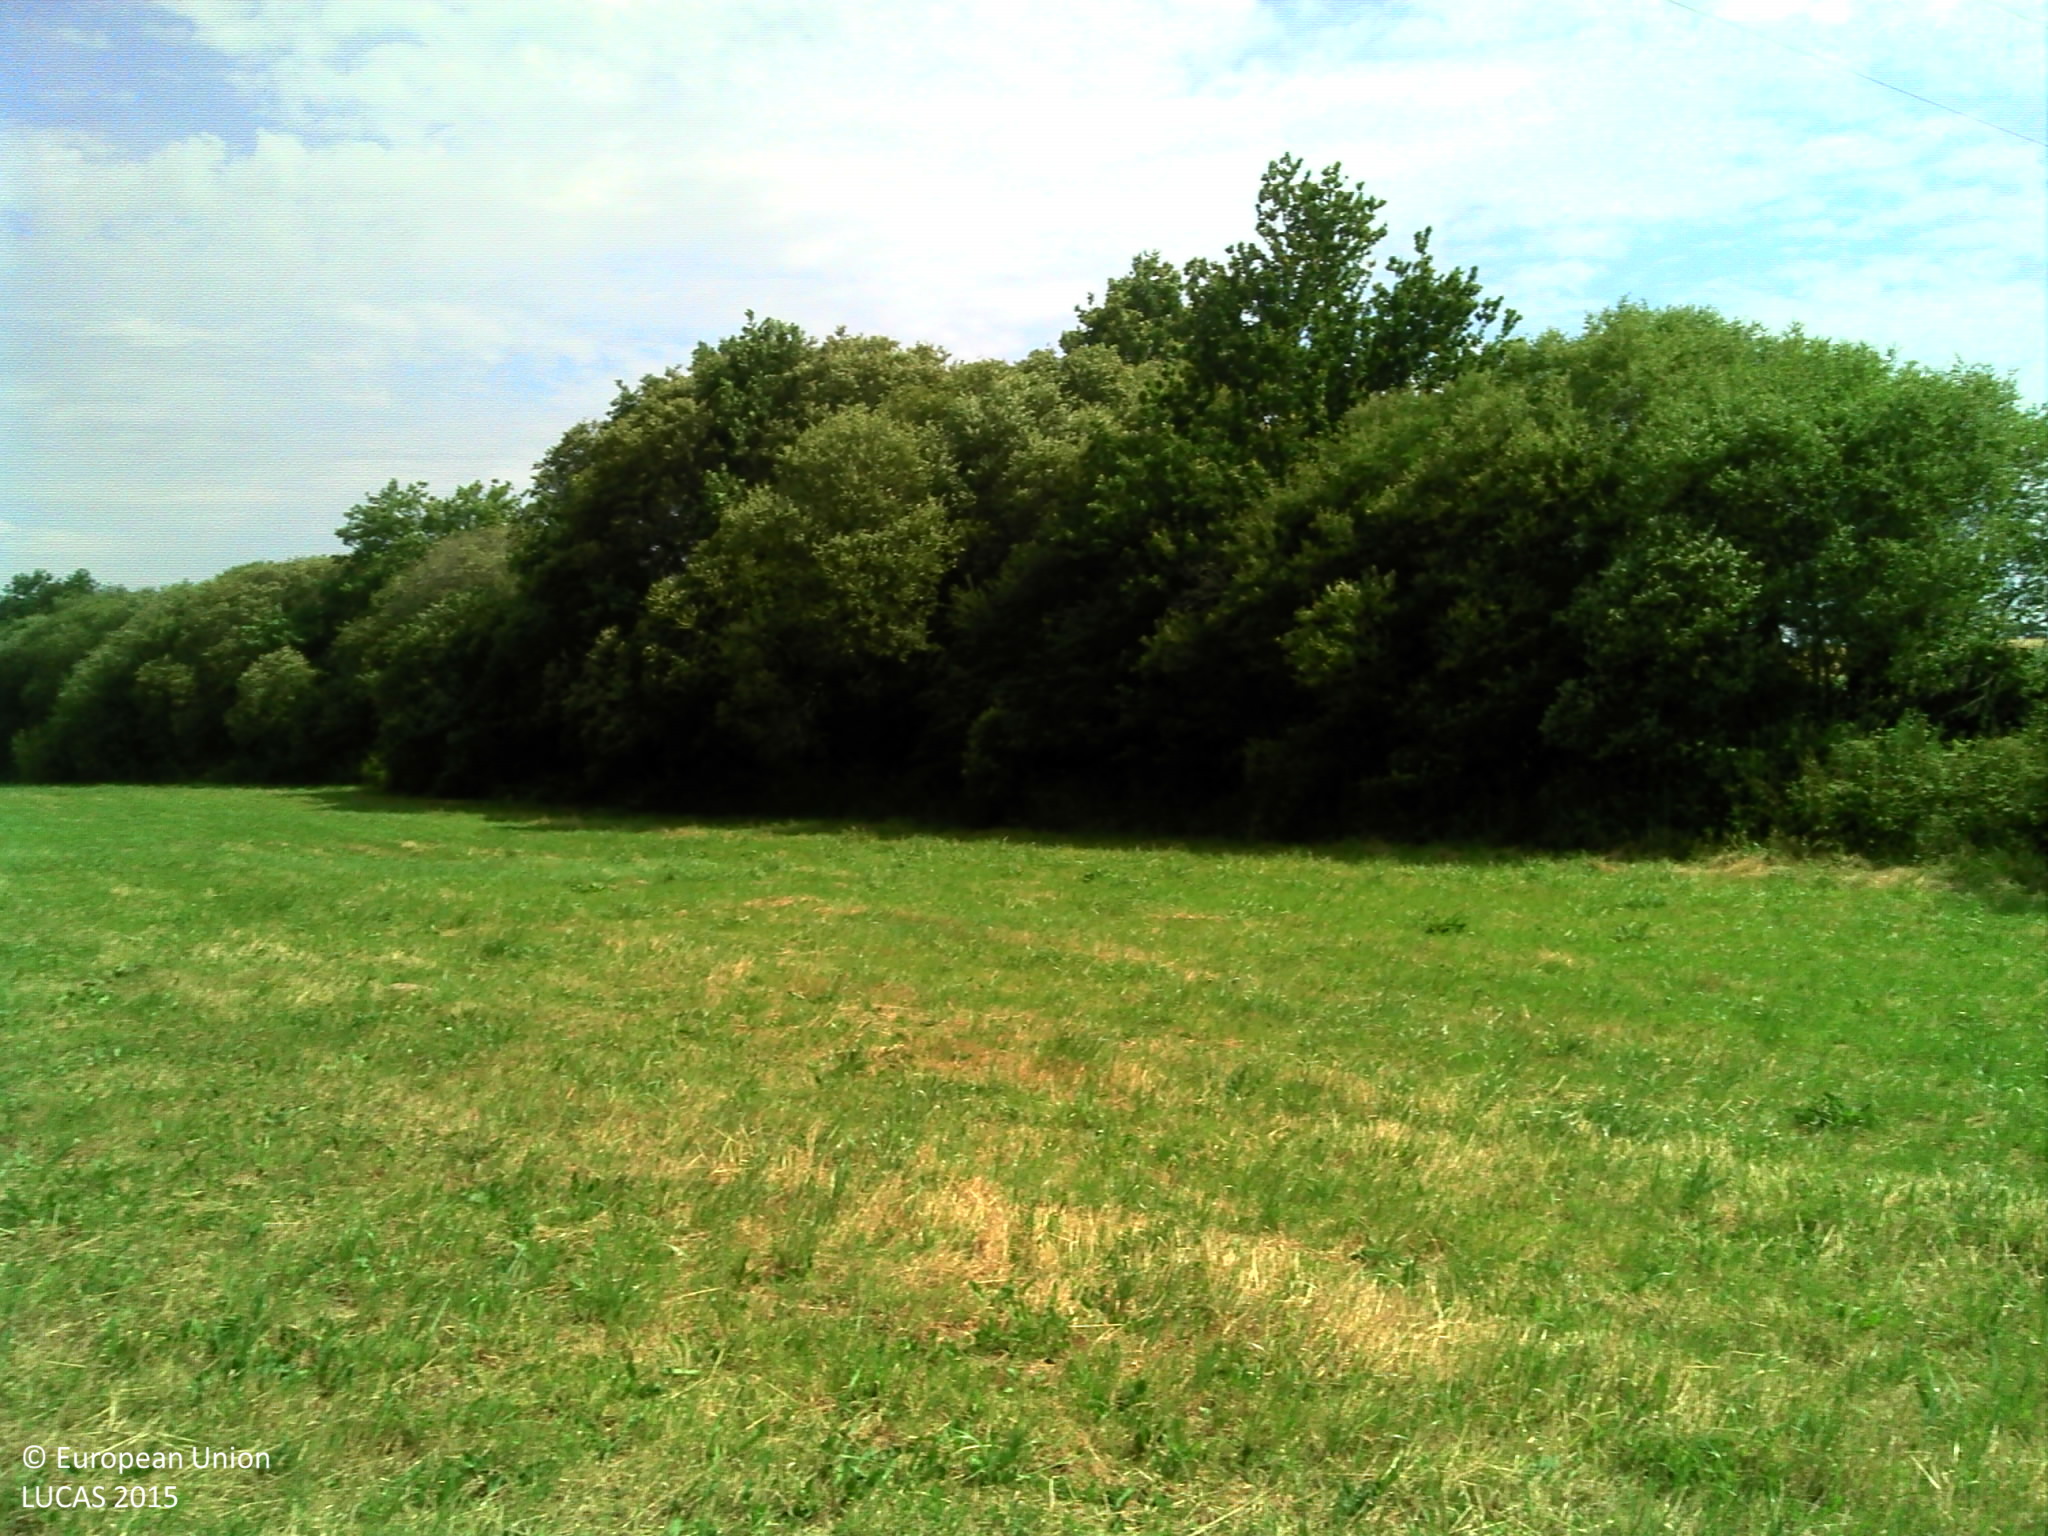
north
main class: Grassland
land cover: Grassland without tree/shrub cover
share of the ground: > 75 %
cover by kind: herbaceous plants 100 %
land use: Agriculture (excluding fallow land and kitchen gardens)
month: June
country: FR
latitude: 47.9229
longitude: -2.0568
